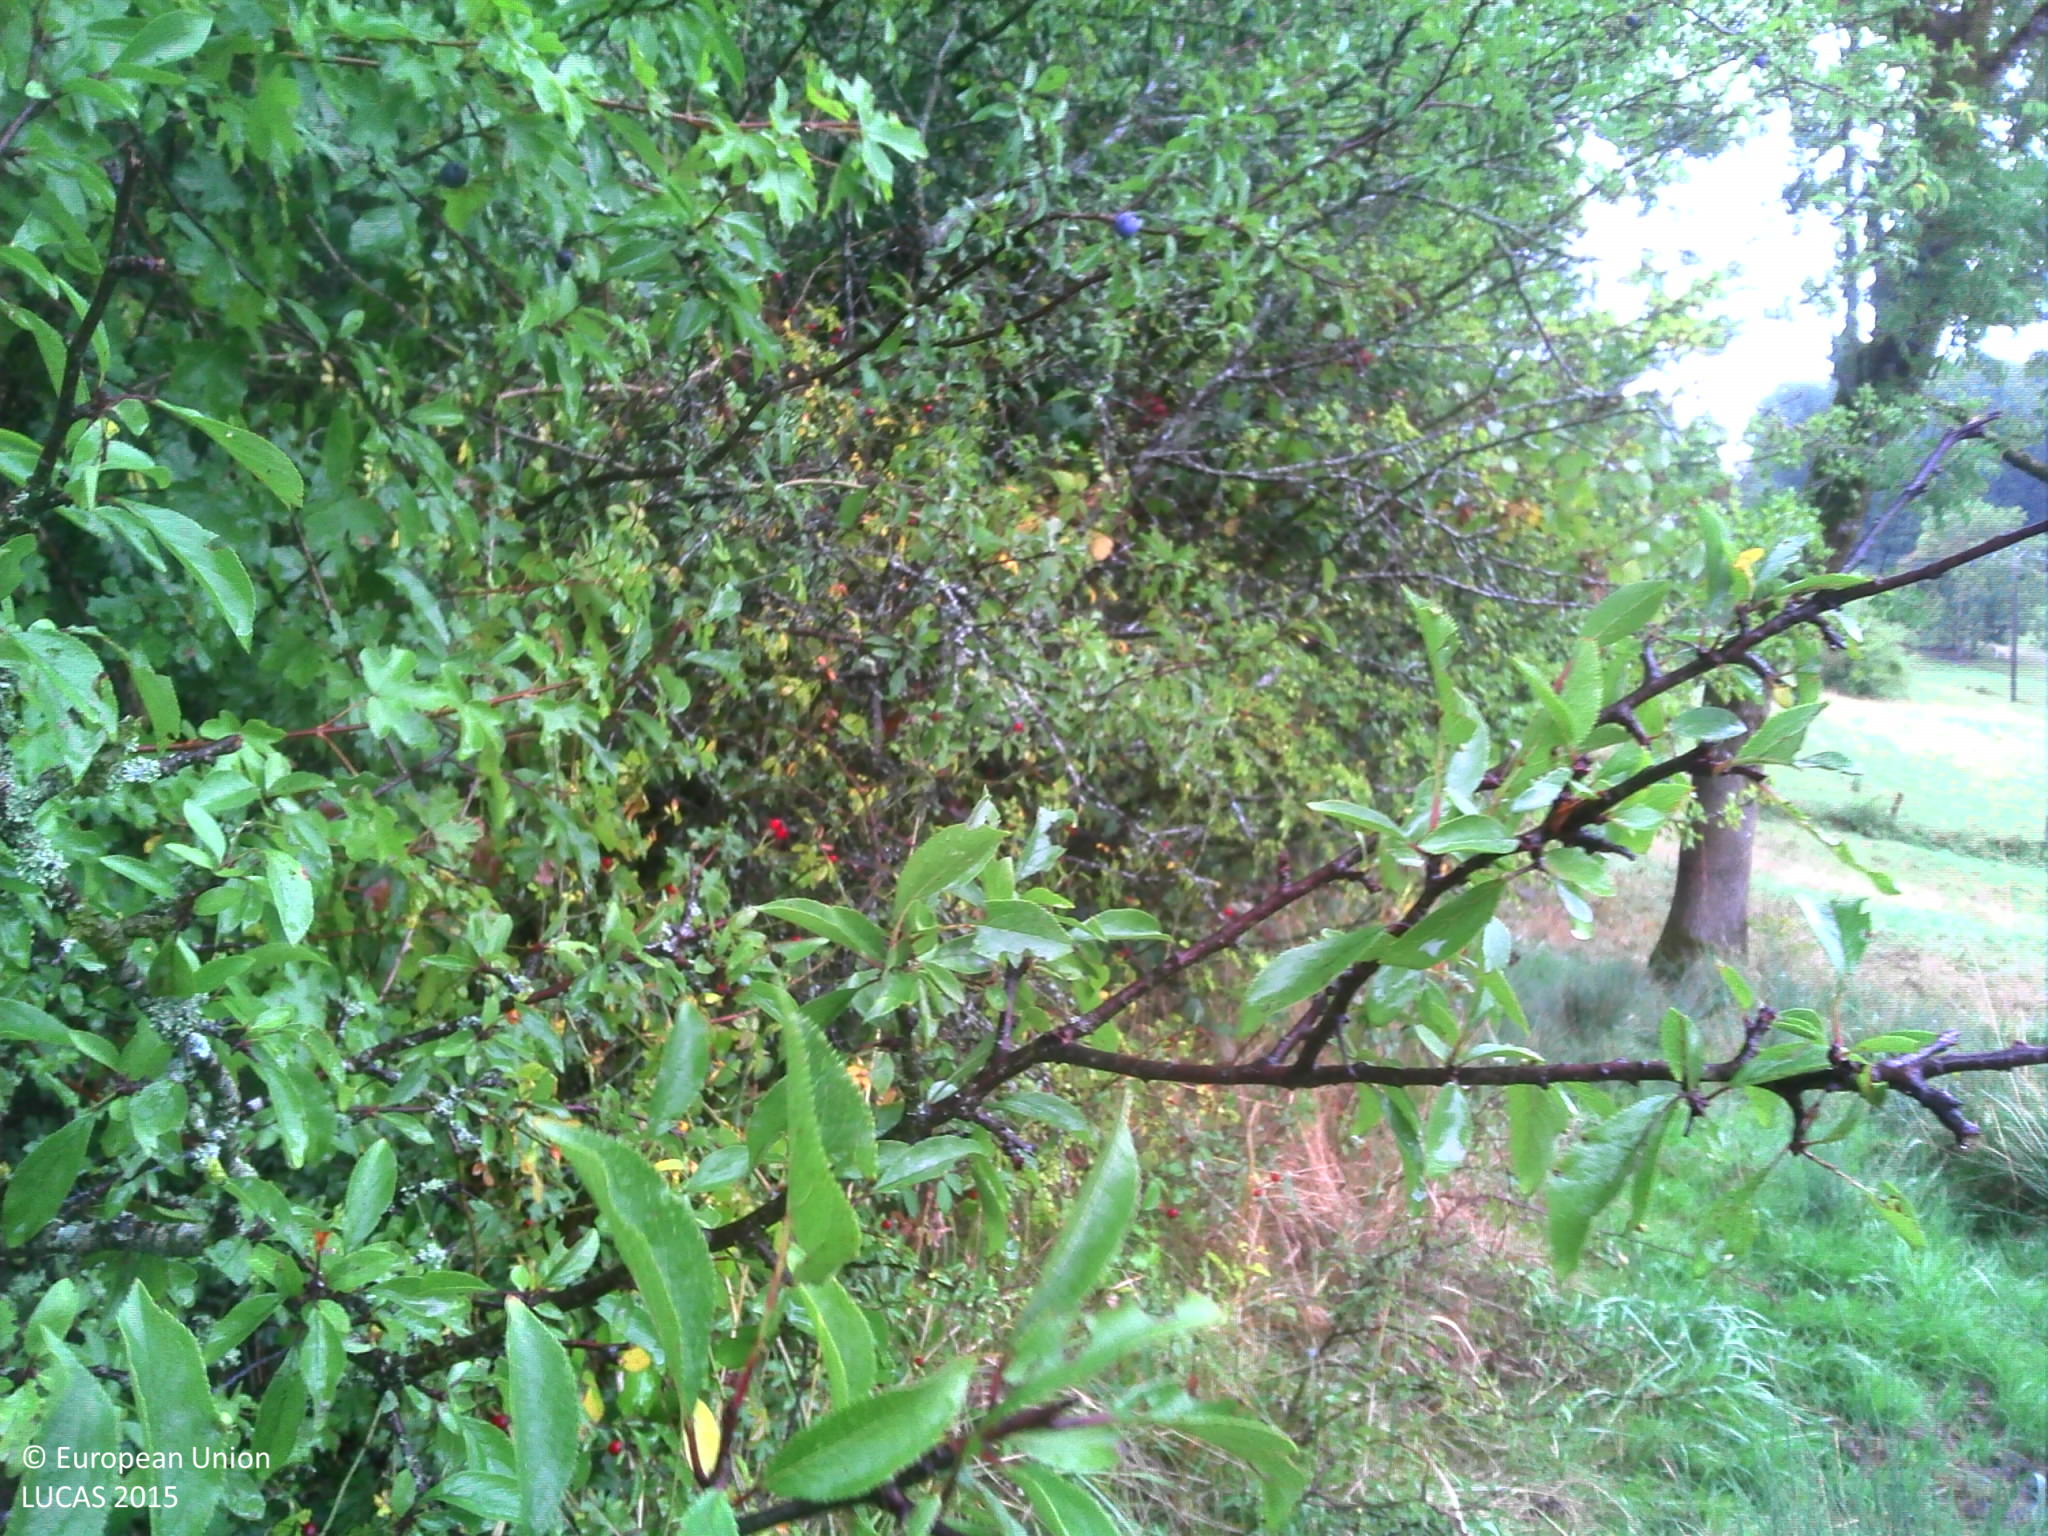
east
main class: Woodland
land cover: Broadleaved woodland
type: mesophytic deciduous forest
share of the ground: > 75 %
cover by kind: broadleaved forest trees 70 %, shrubs 20 %, herbaceous plants 10 %
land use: Semi-natural and natural areas not in use
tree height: > 5 m
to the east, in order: Broadleaved woodland; Grass margins; Paved roads, cycling and walking lanes; Grass margins; Broadleaved woodland; Fences; Broadleaved woodland; Grassland without tree/shrub cover; Fences; Broadleaved woodland; Grassland without tree/shrub cover; Electric lines; Grassland without tree/shrub cover
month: September
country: FR
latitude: 47.2159
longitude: 6.0537
